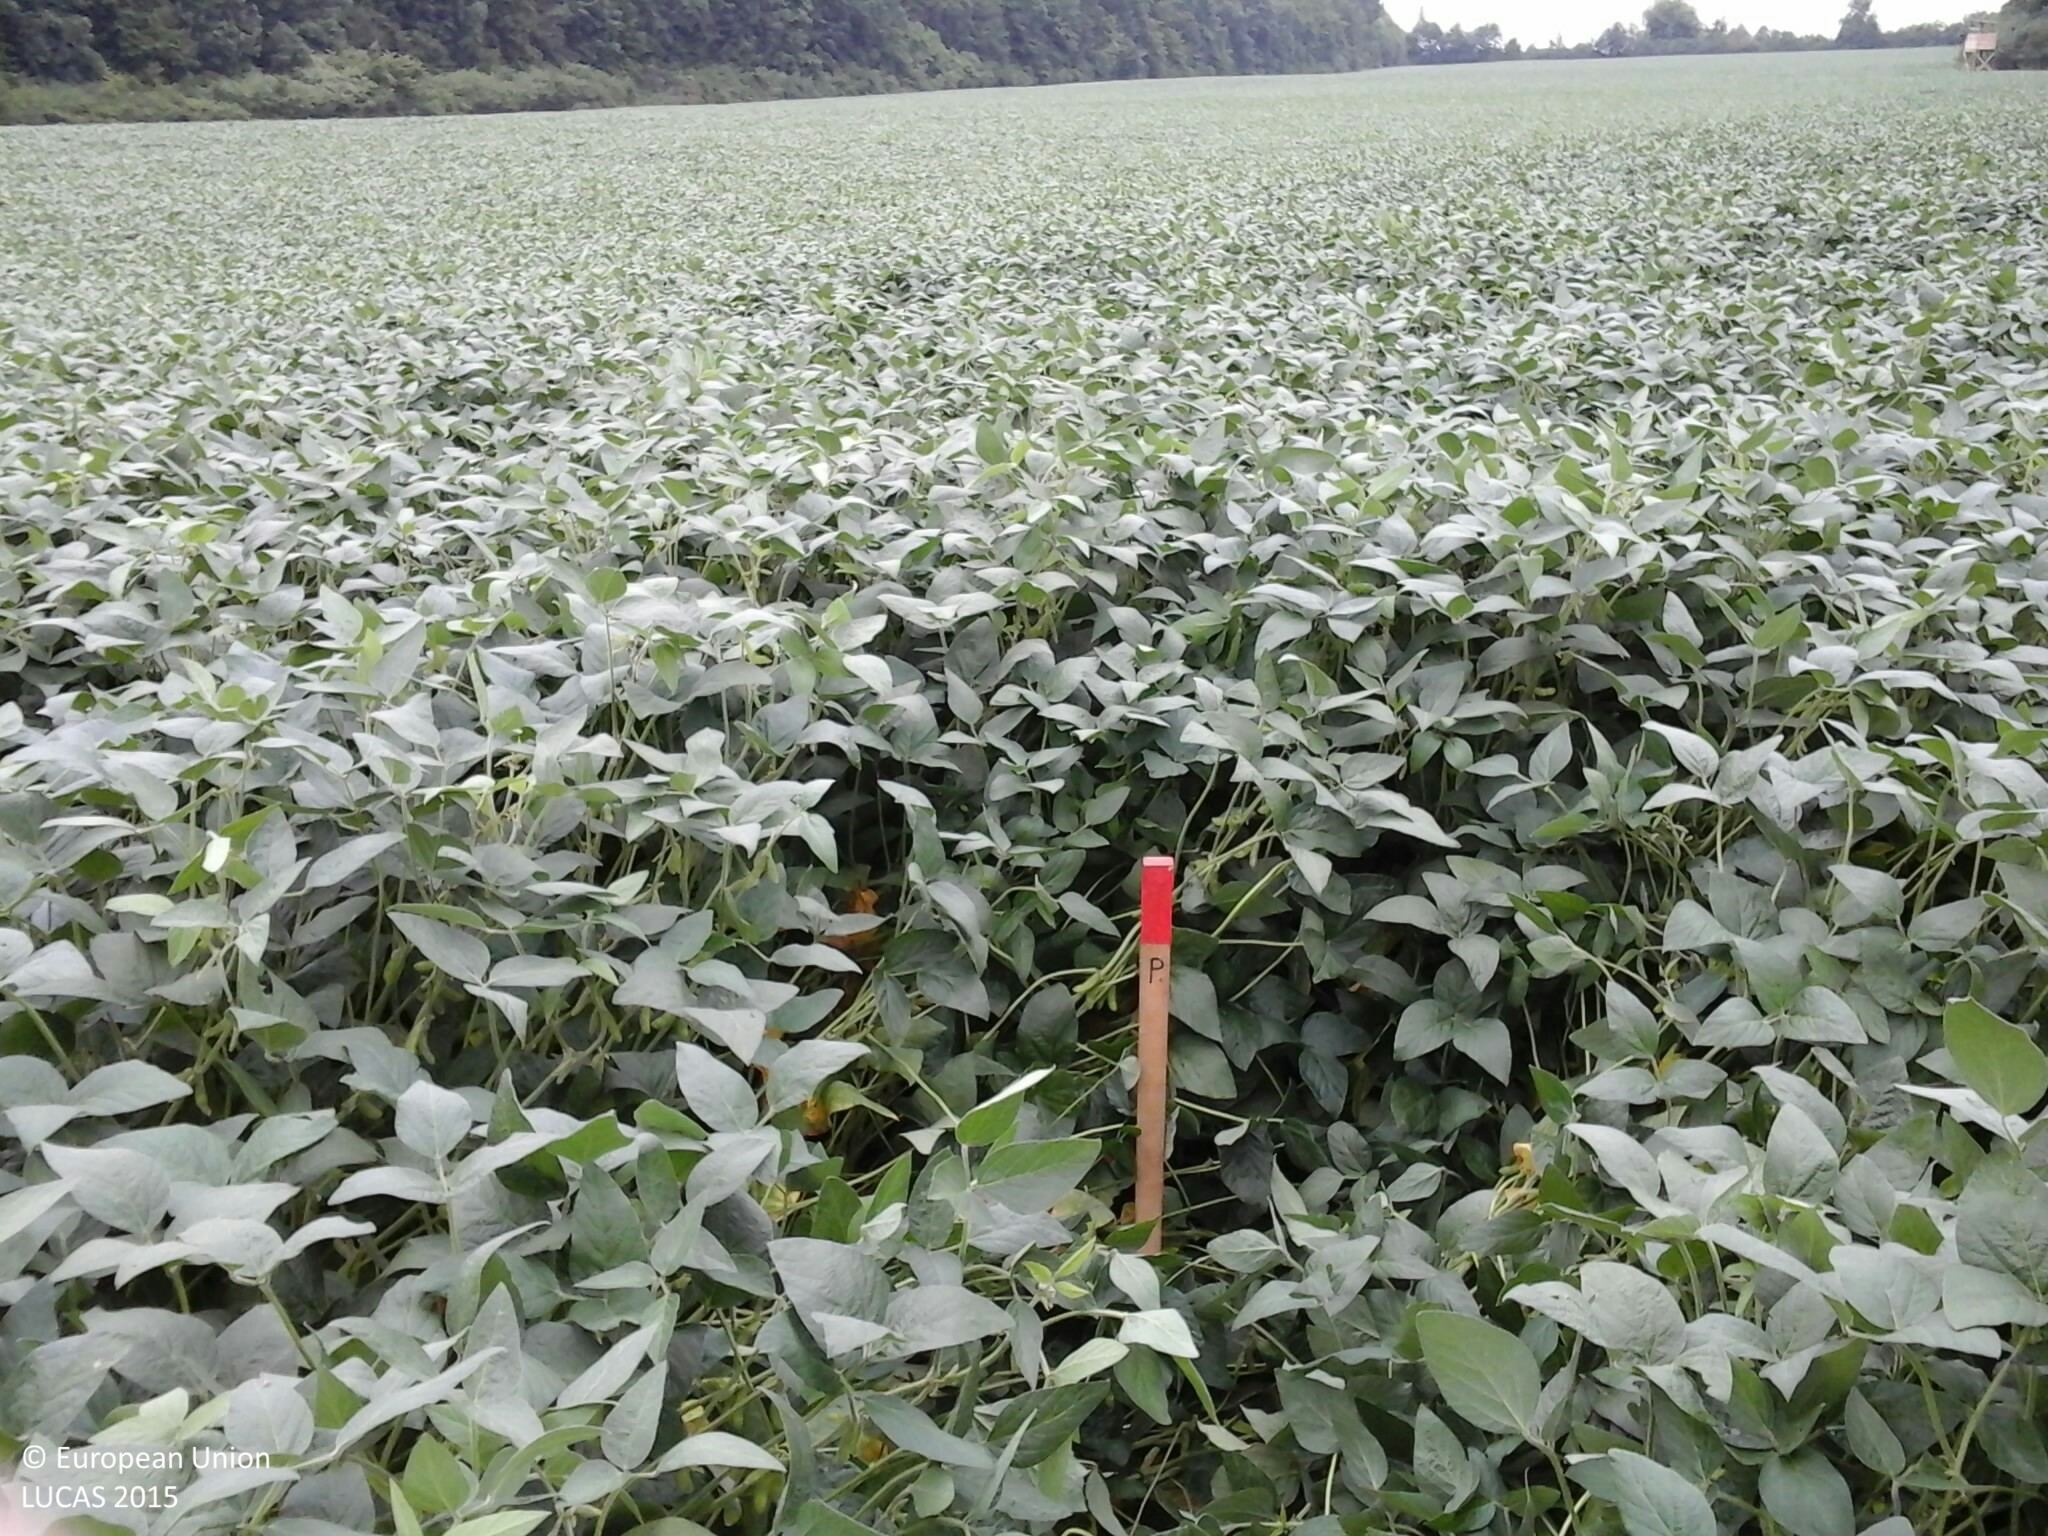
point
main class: Cropland
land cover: Soya
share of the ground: > 75 %
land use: Agriculture (excluding fallow land and kitchen gardens)
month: July
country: HU
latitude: 46.7180
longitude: 16.4250
